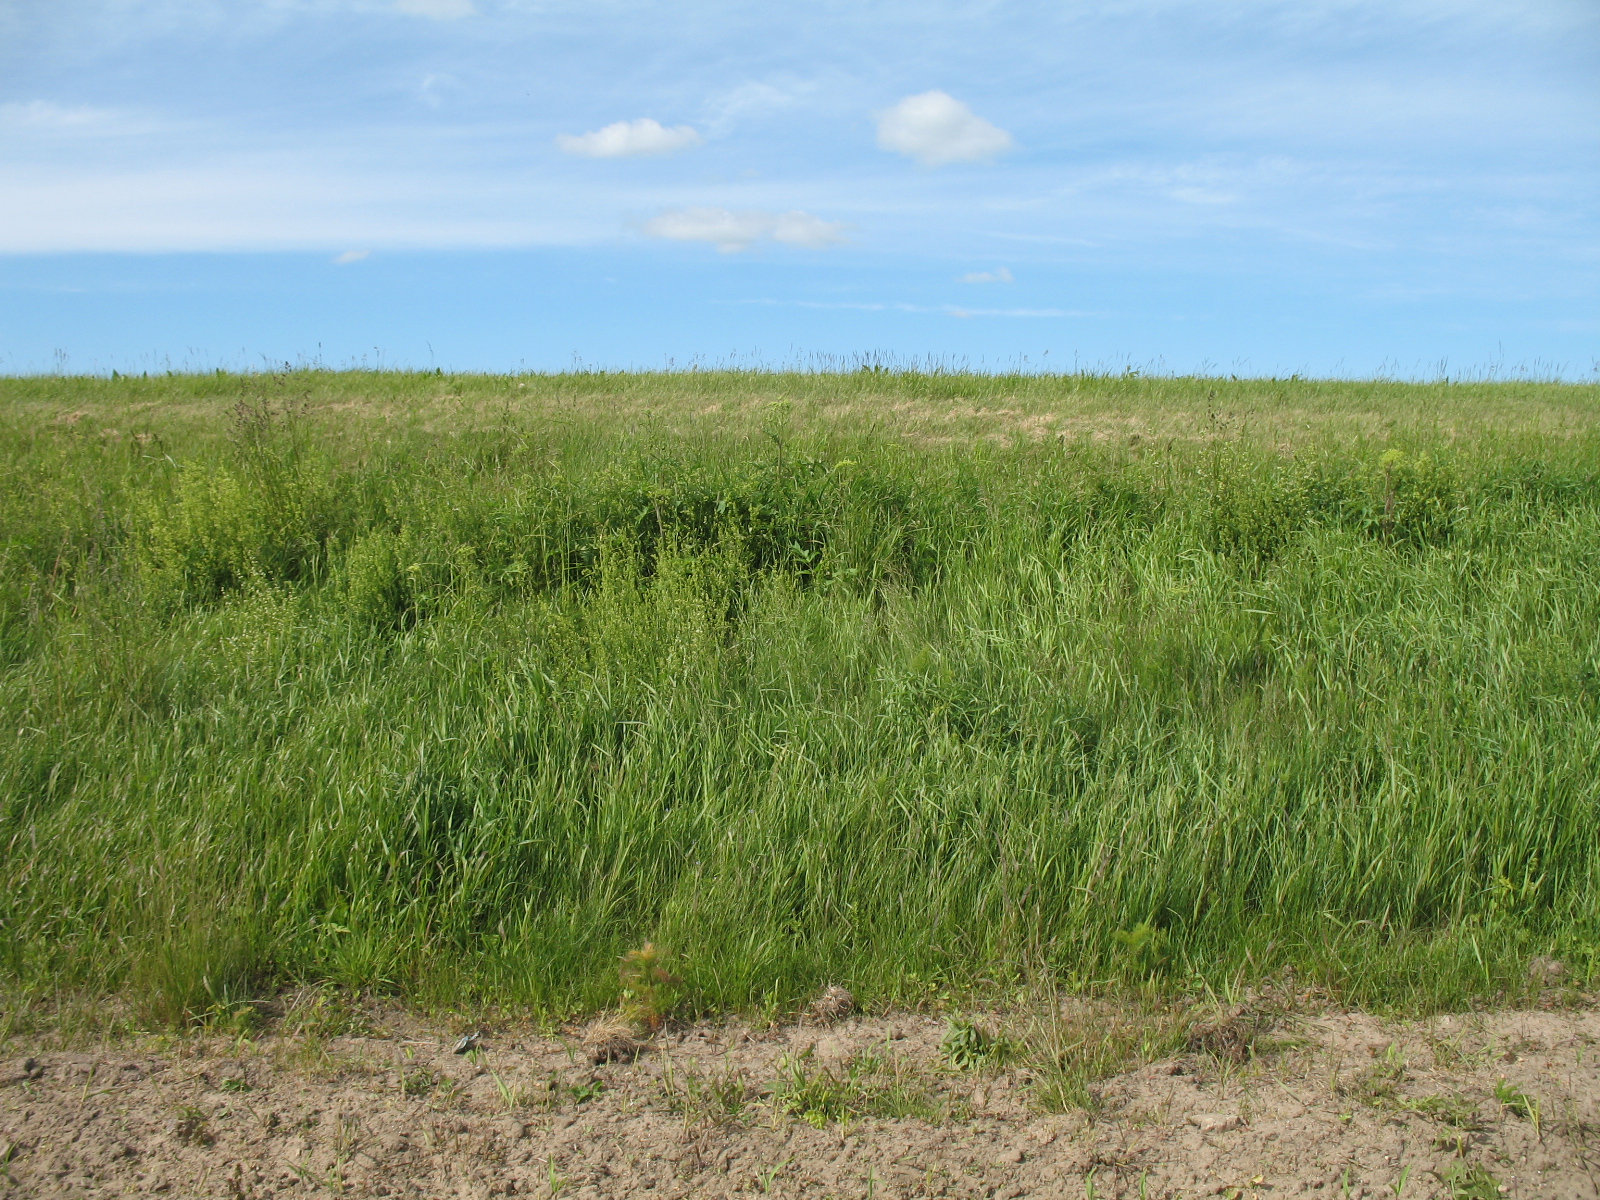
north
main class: Cropland
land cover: Maize
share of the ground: < 10 %
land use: Agriculture (excluding fallow land and kitchen gardens)
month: June
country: LV
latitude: 56.6218
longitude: 23.4873
